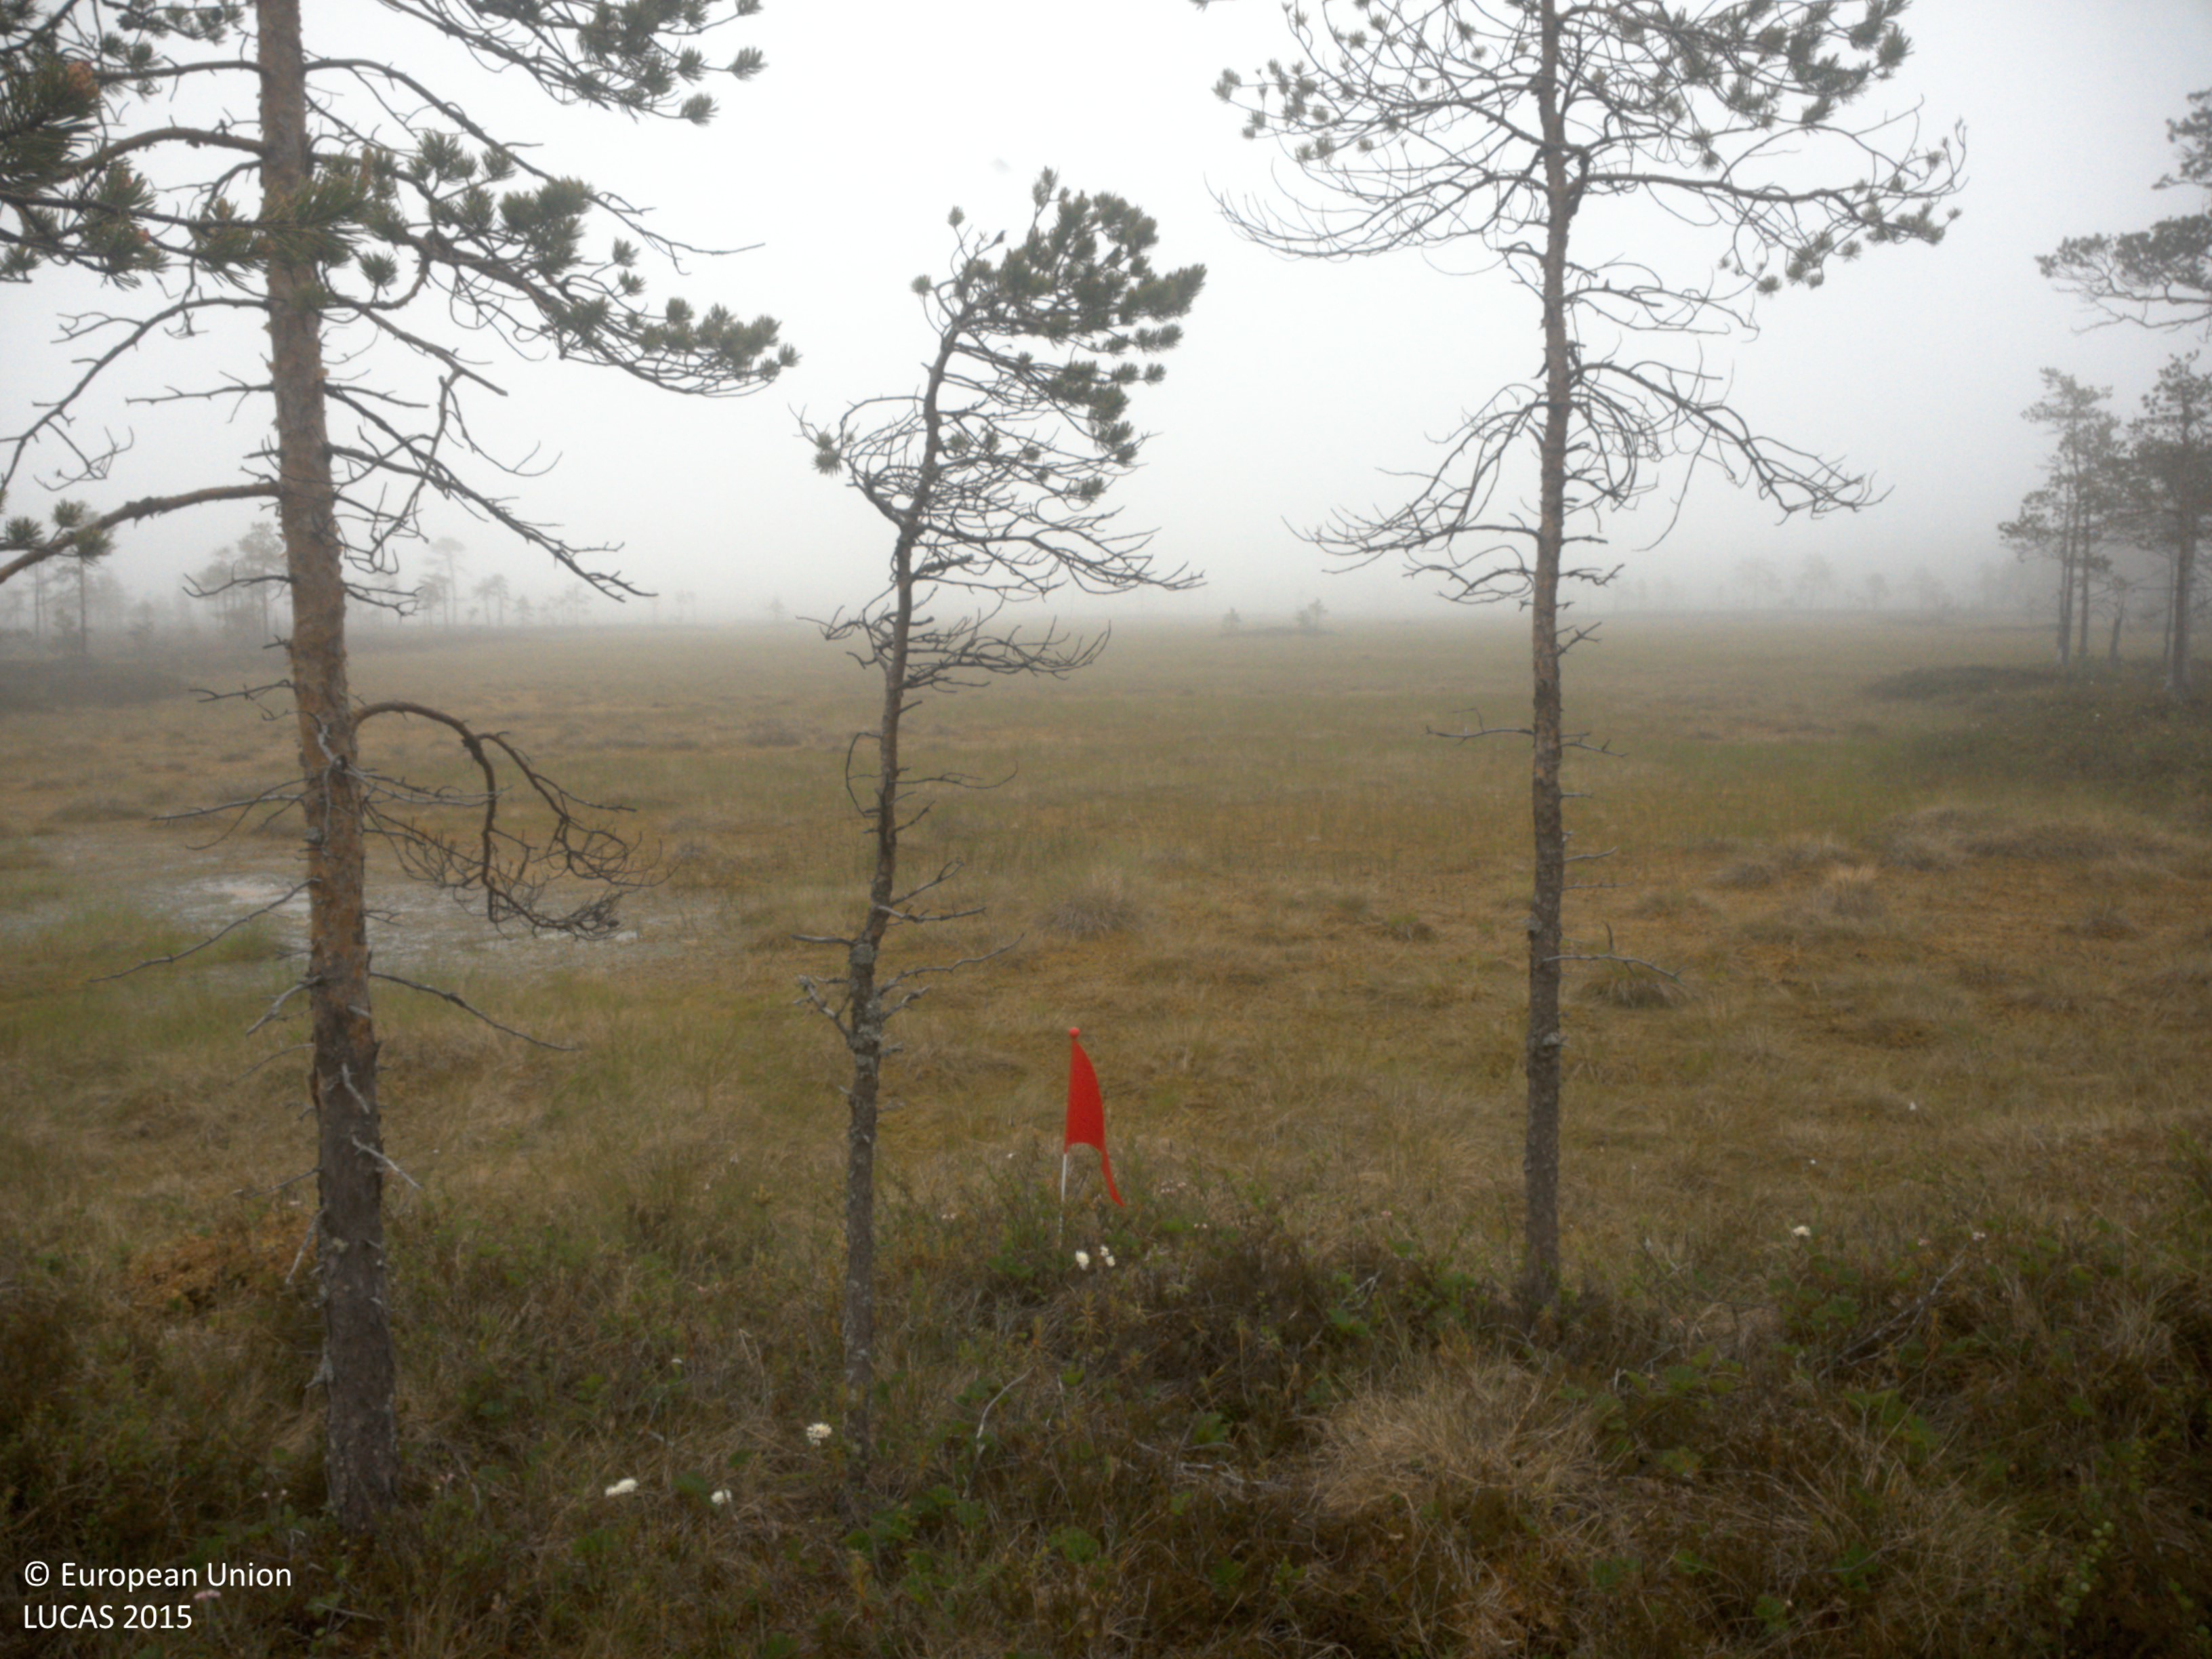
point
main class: Woodland
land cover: Pine dominated coniferous woodland
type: boreal forest
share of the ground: 10 - 25 %
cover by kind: lichens and mosses 55 %, shrubs 30 %, coniferous forest trees 15 %
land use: Semi-natural and natural areas not in use
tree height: > 5 m
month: June
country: SE
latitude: 63.6256
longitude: 19.7255
